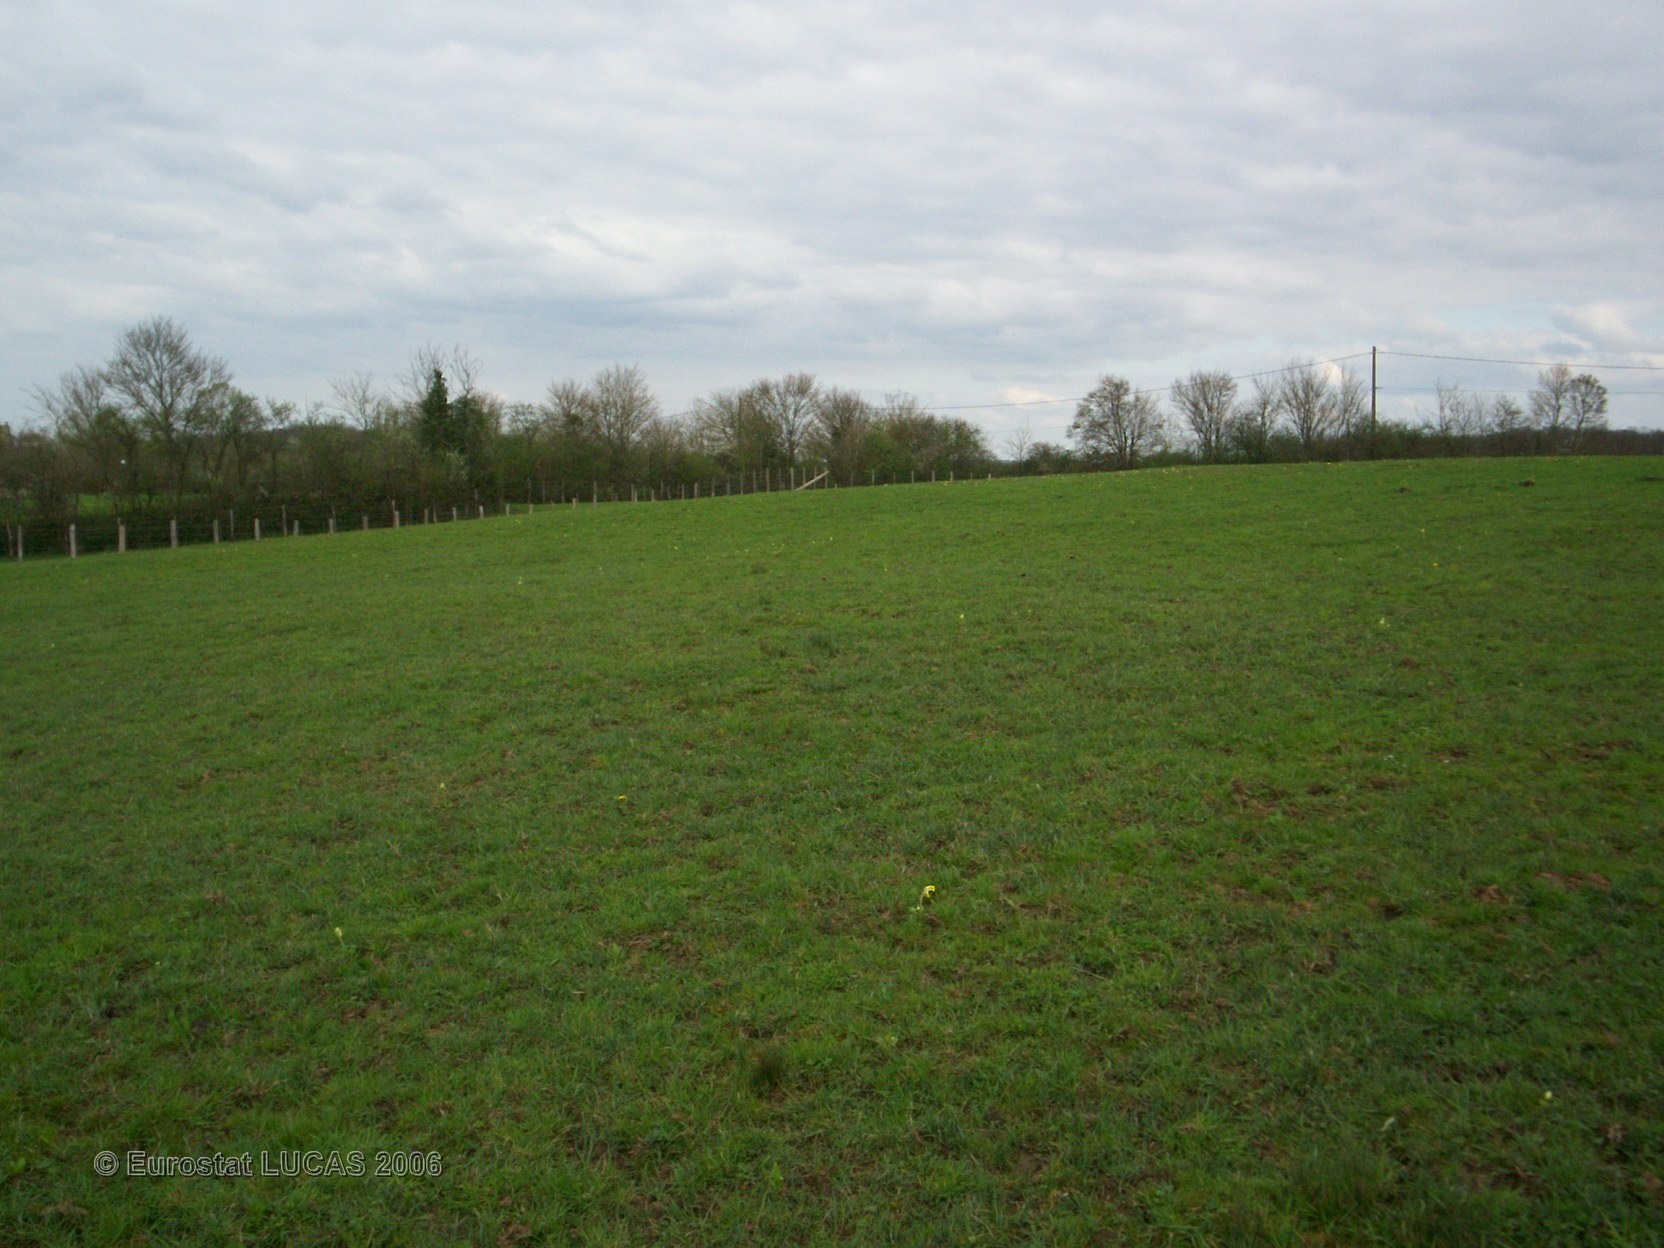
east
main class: Grassland
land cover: Grassland without tree/shrub cover
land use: Agriculture (excluding fallow land and kitchen gardens)
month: April
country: FR
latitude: 48.2340
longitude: 0.3482
